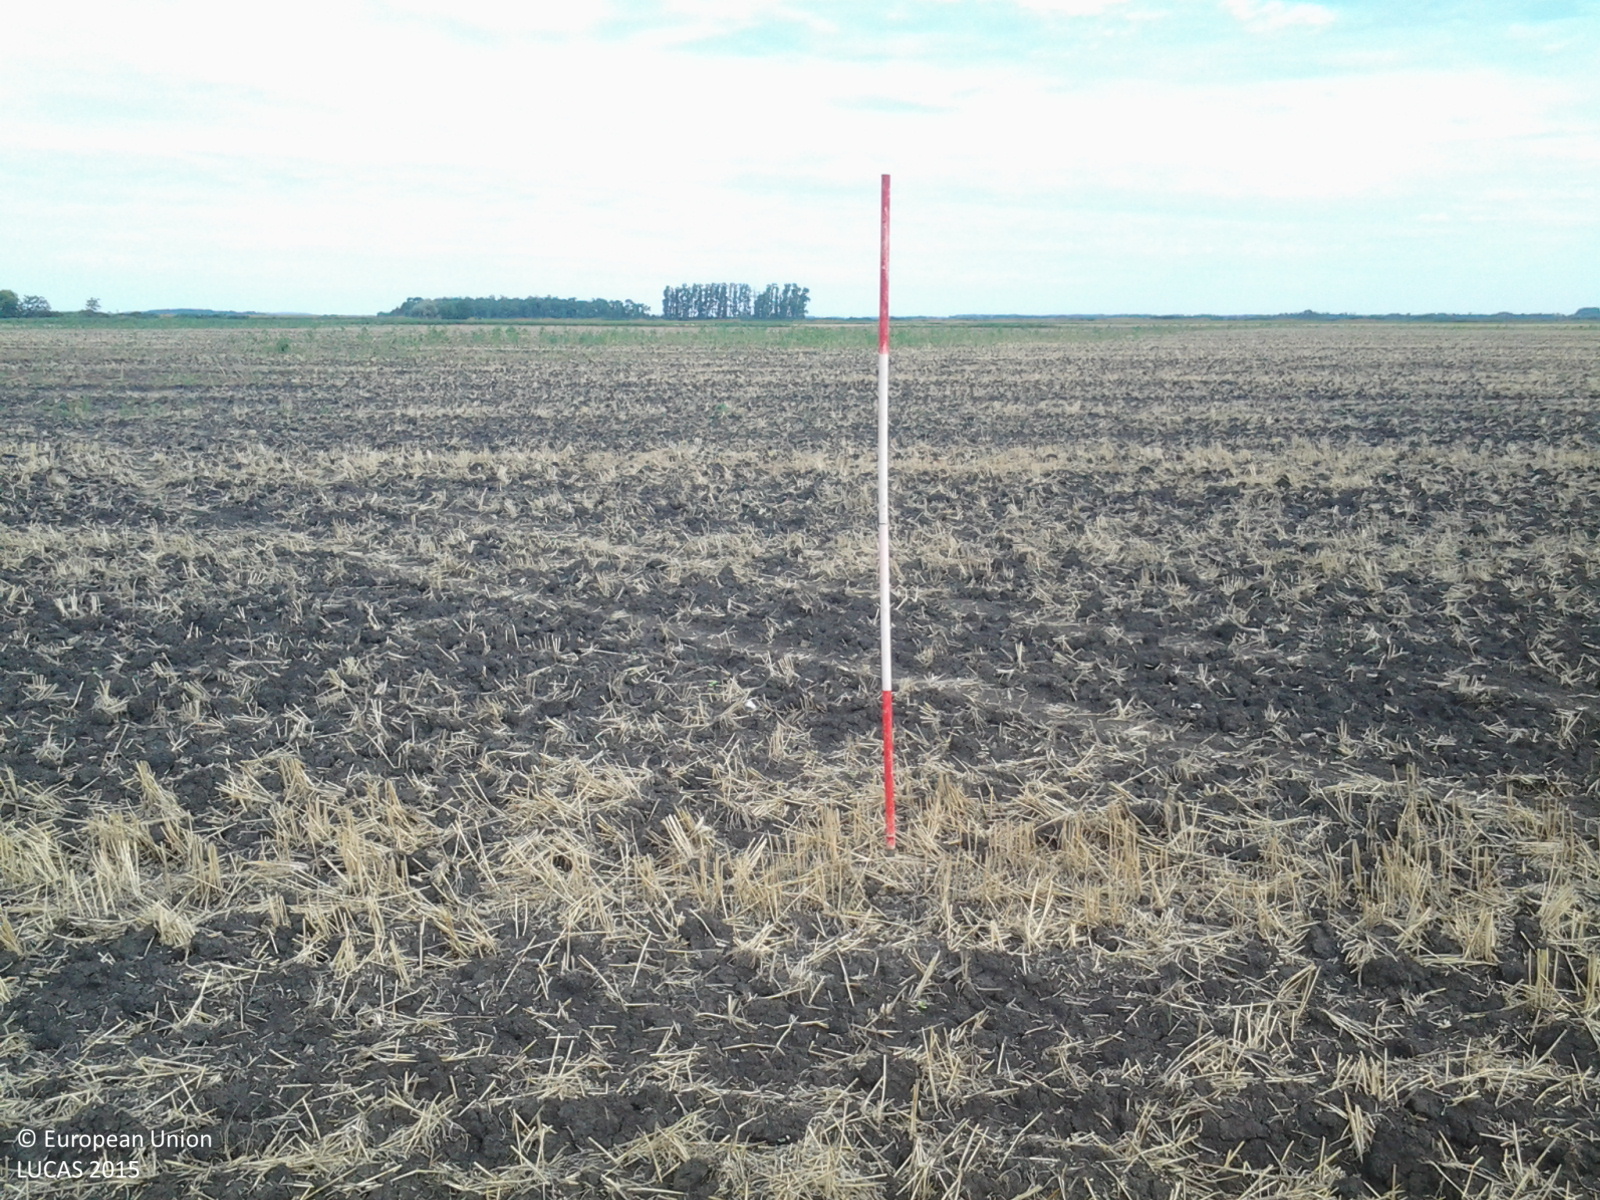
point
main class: Cropland
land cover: Common wheat
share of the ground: < 10 %
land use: Agriculture (excluding fallow land and kitchen gardens)
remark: Harvested field
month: July
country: HU
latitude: 47.1361
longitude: 21.2581
